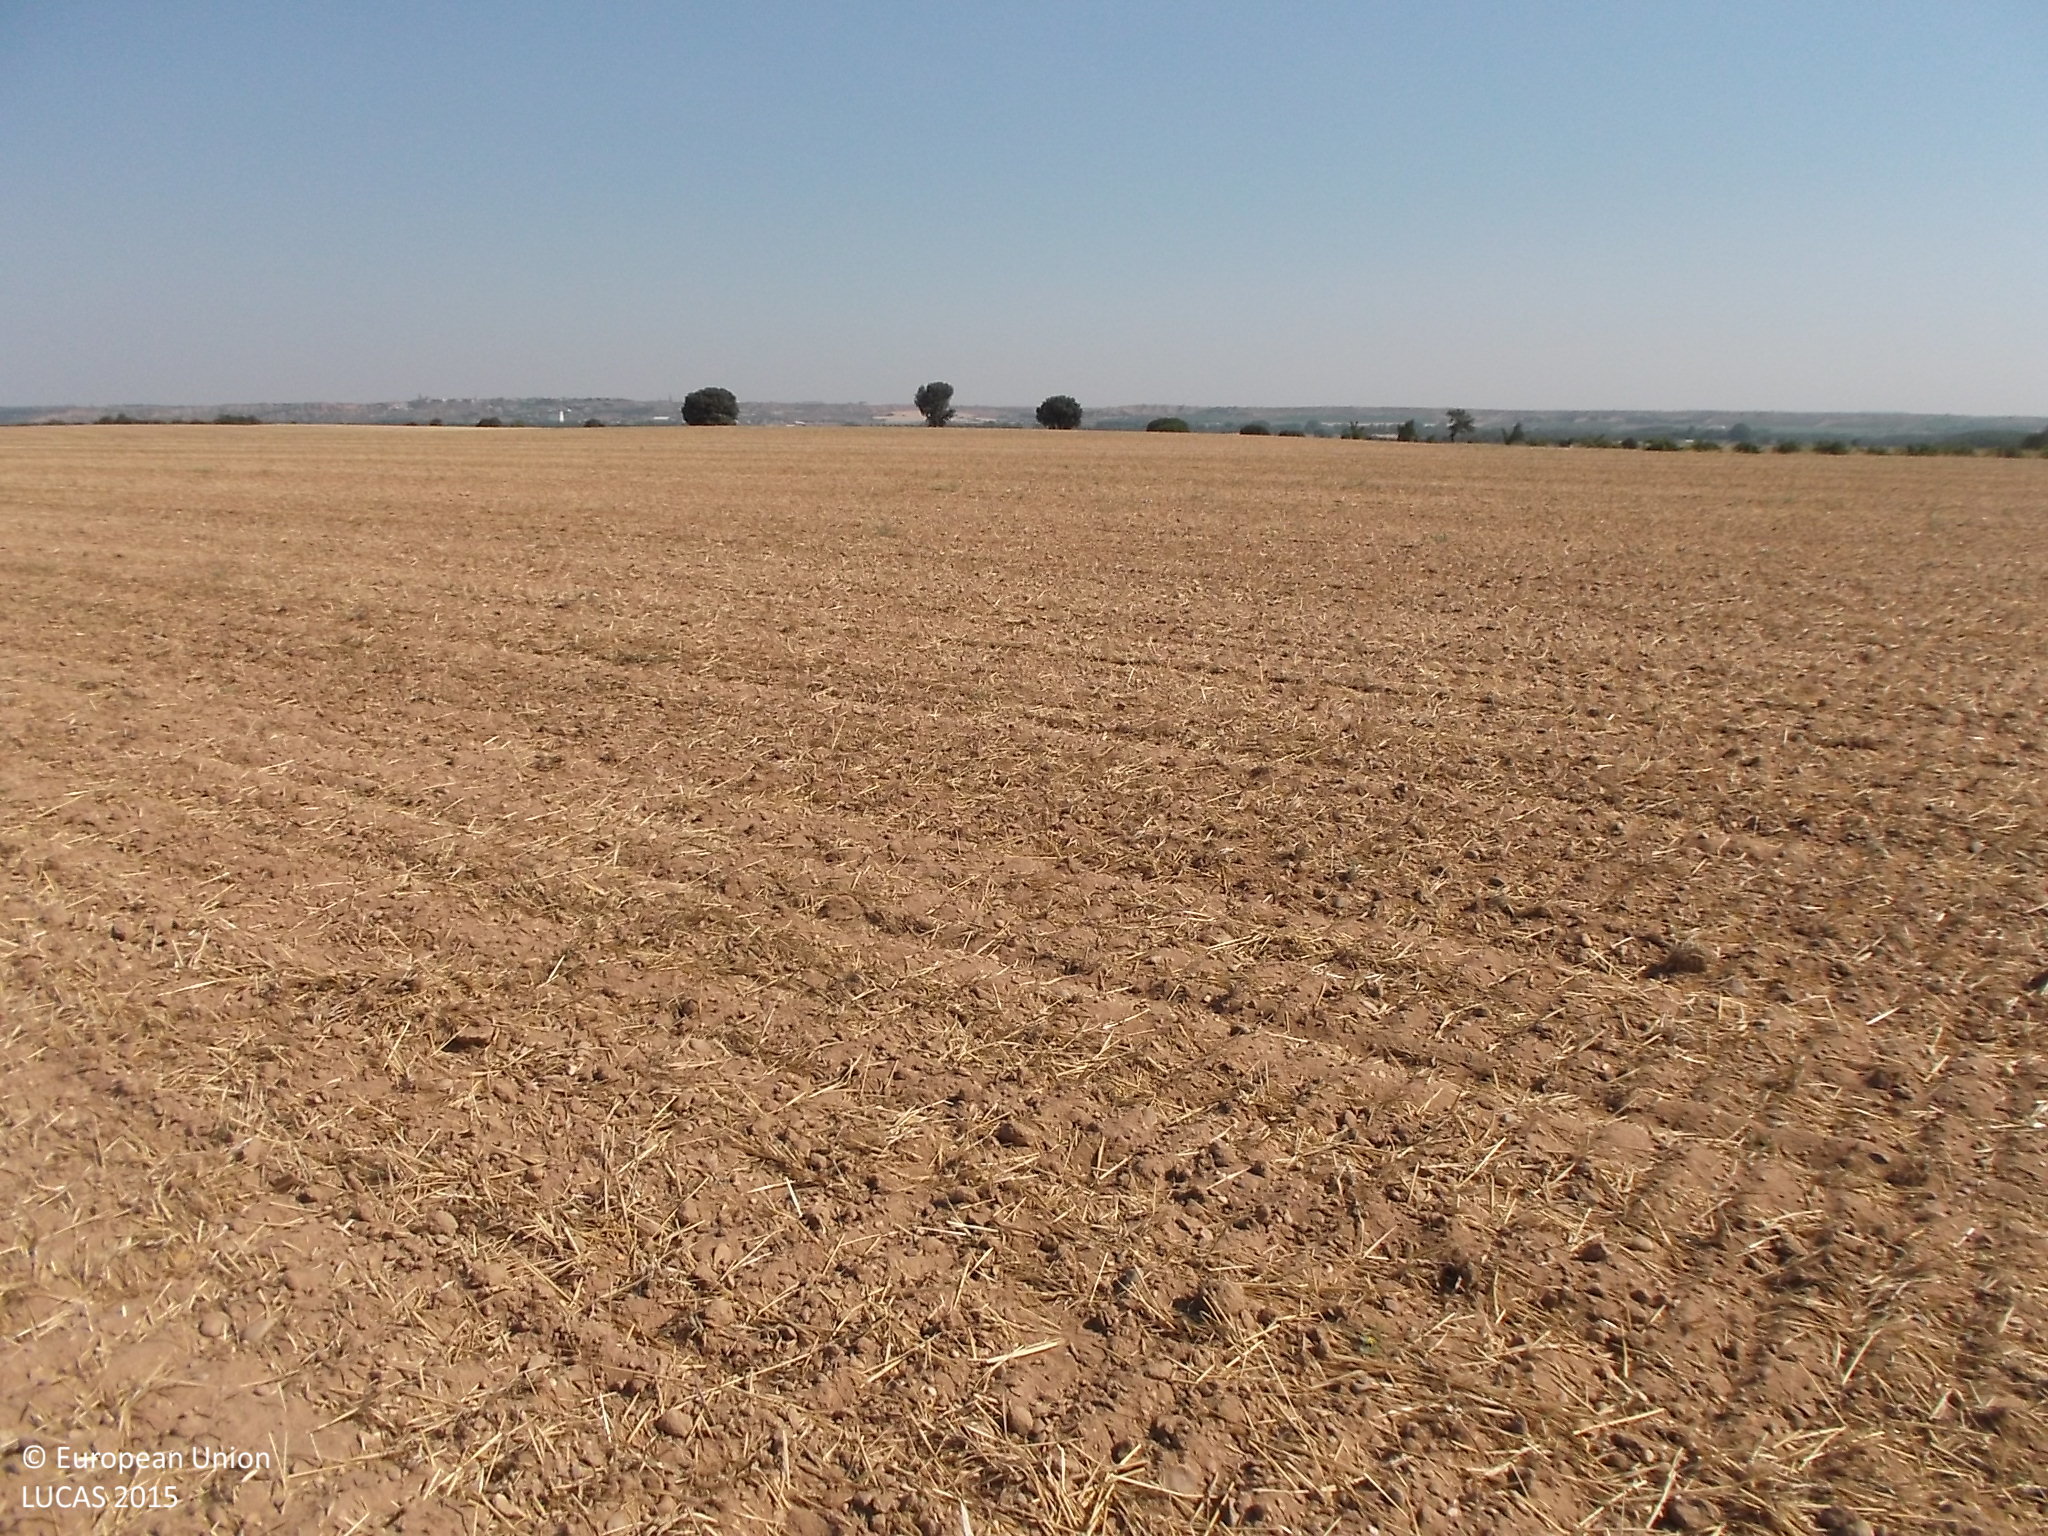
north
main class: Cropland
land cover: Oats
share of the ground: < 10 %
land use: Agriculture (excluding fallow land and kitchen gardens)
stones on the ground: 10 - 25 %
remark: Harvested field
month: July
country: ES
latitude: 41.4551
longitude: -5.3655
